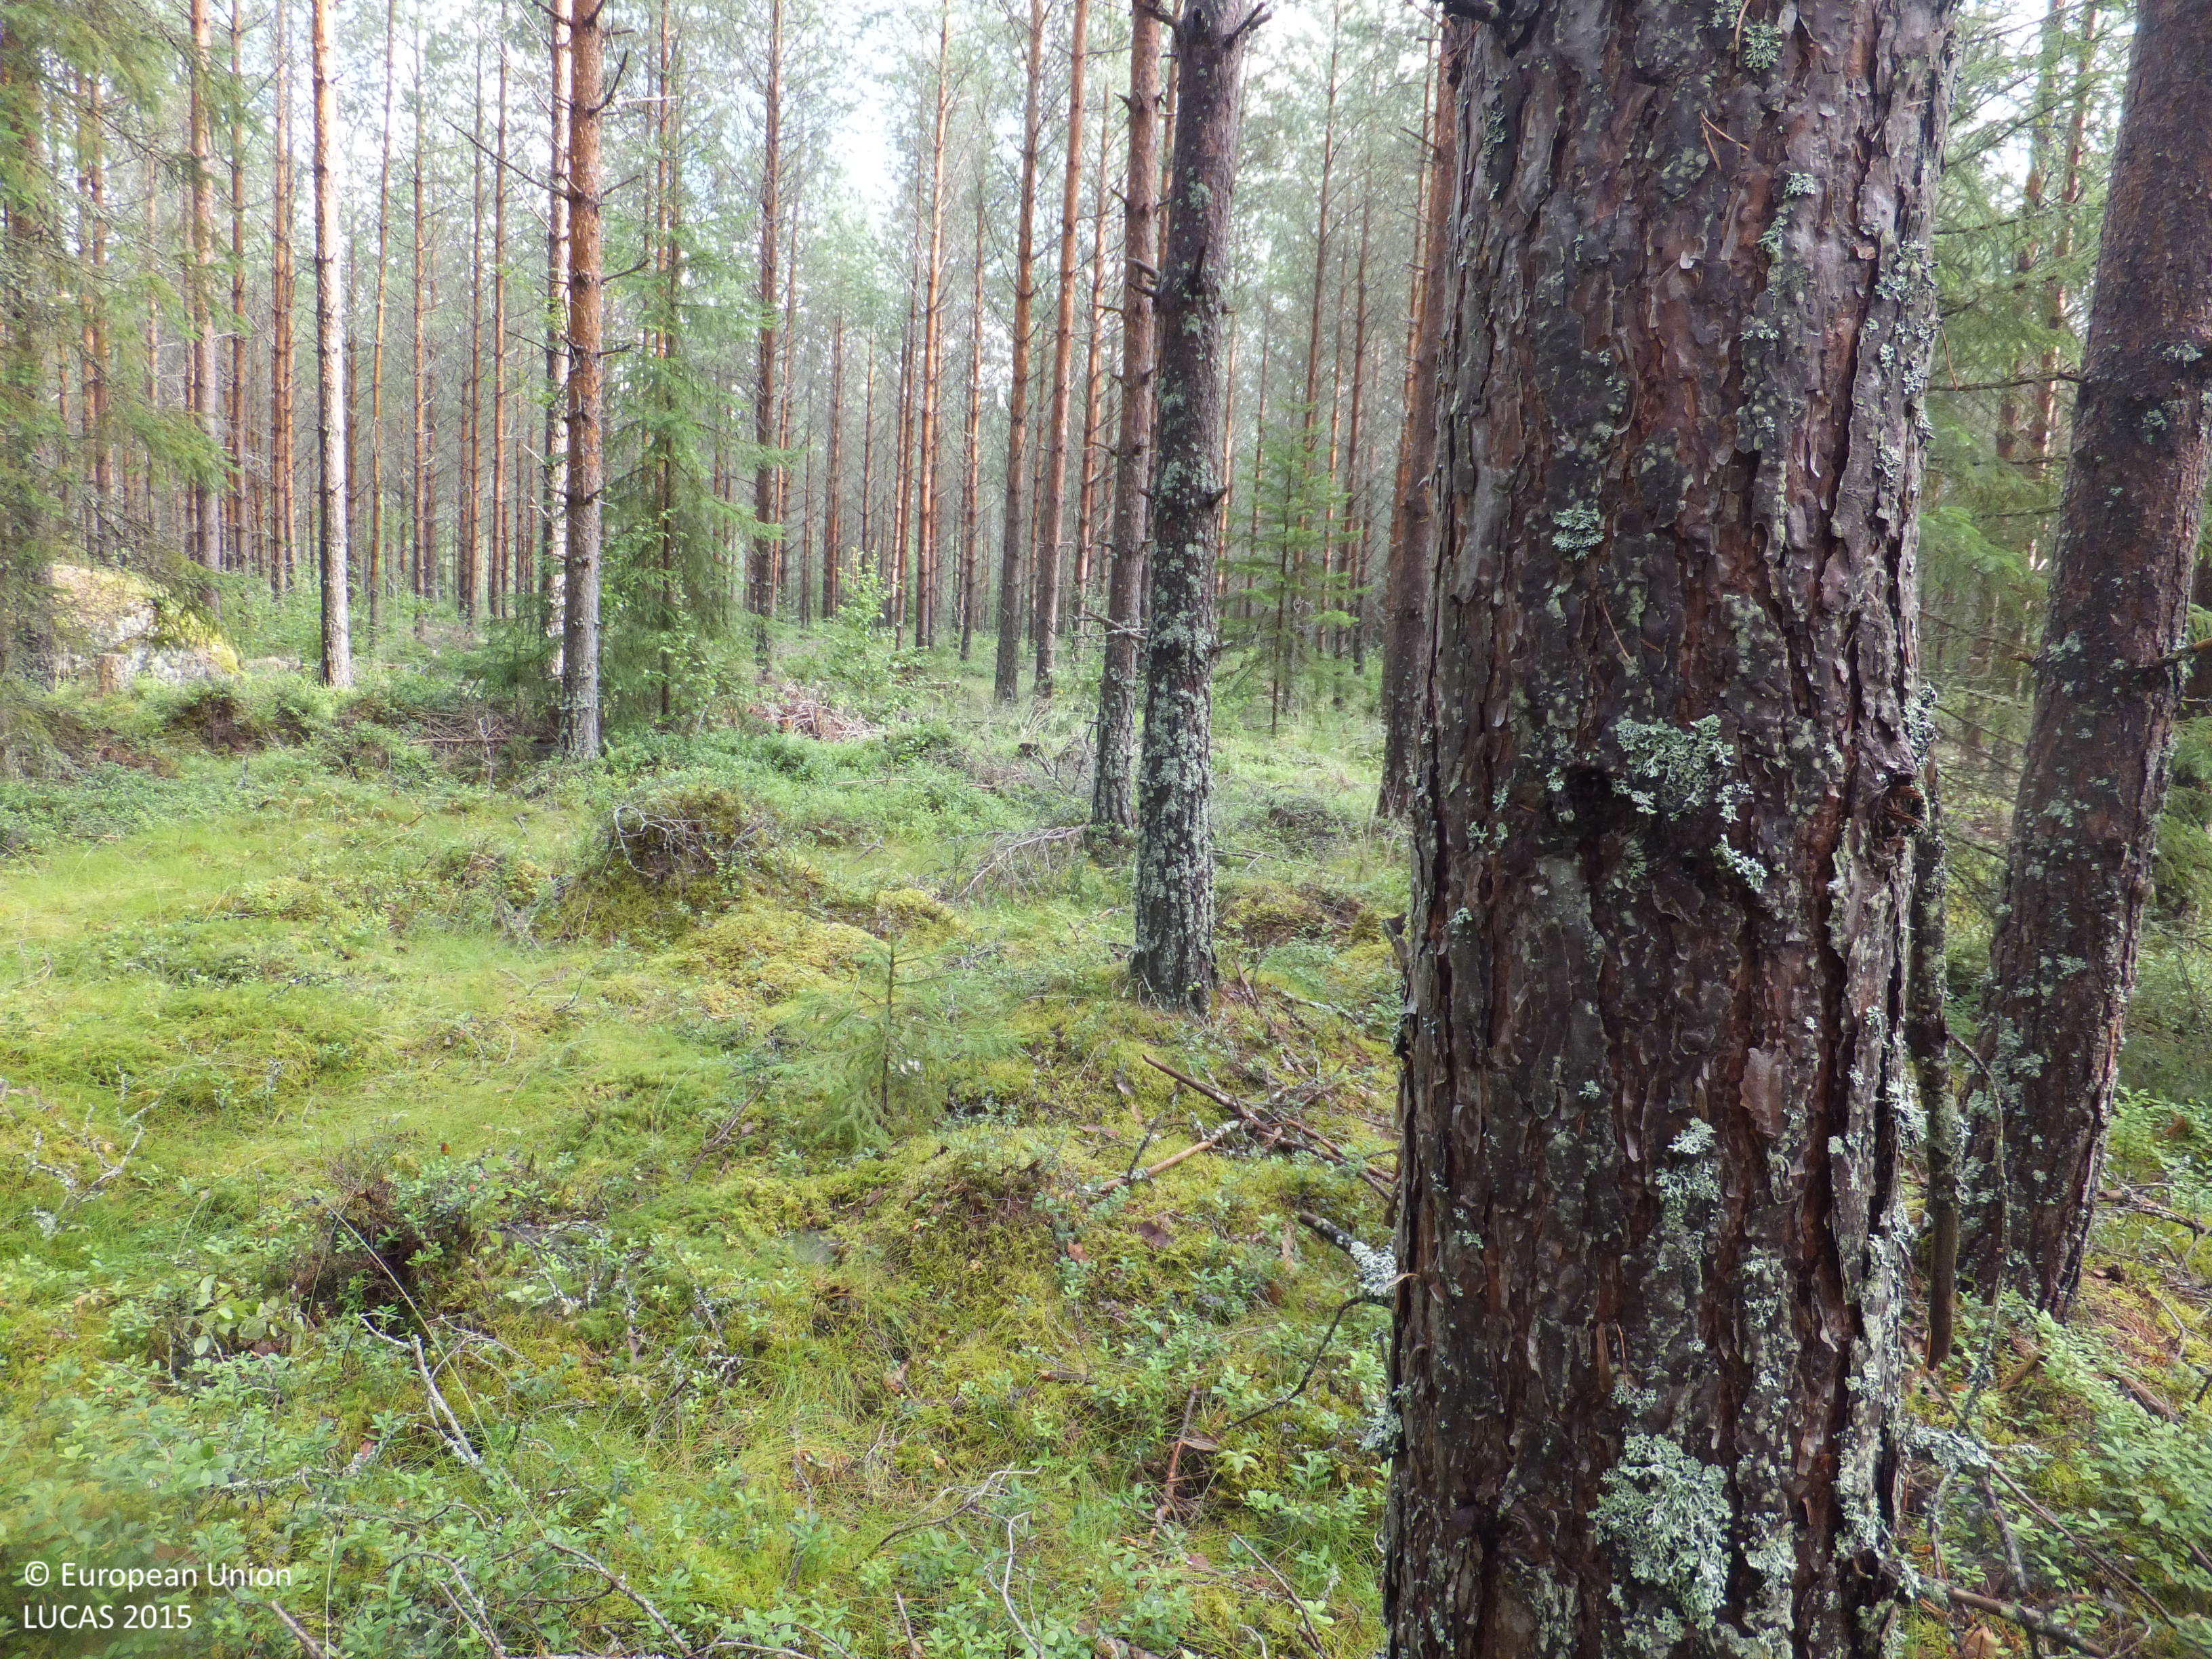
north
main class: Woodland
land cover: Pine dominated coniferous woodland
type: boreal forest
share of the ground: > 75 %
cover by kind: coniferous forest trees 70 %, shrubs 10 %, lichens and mosses 10 %, broadleaved forest trees 5 %, herbaceous plants 5 %
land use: Forestry
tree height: > 5 m
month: July
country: FI
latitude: 63.1711
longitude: 22.0196
